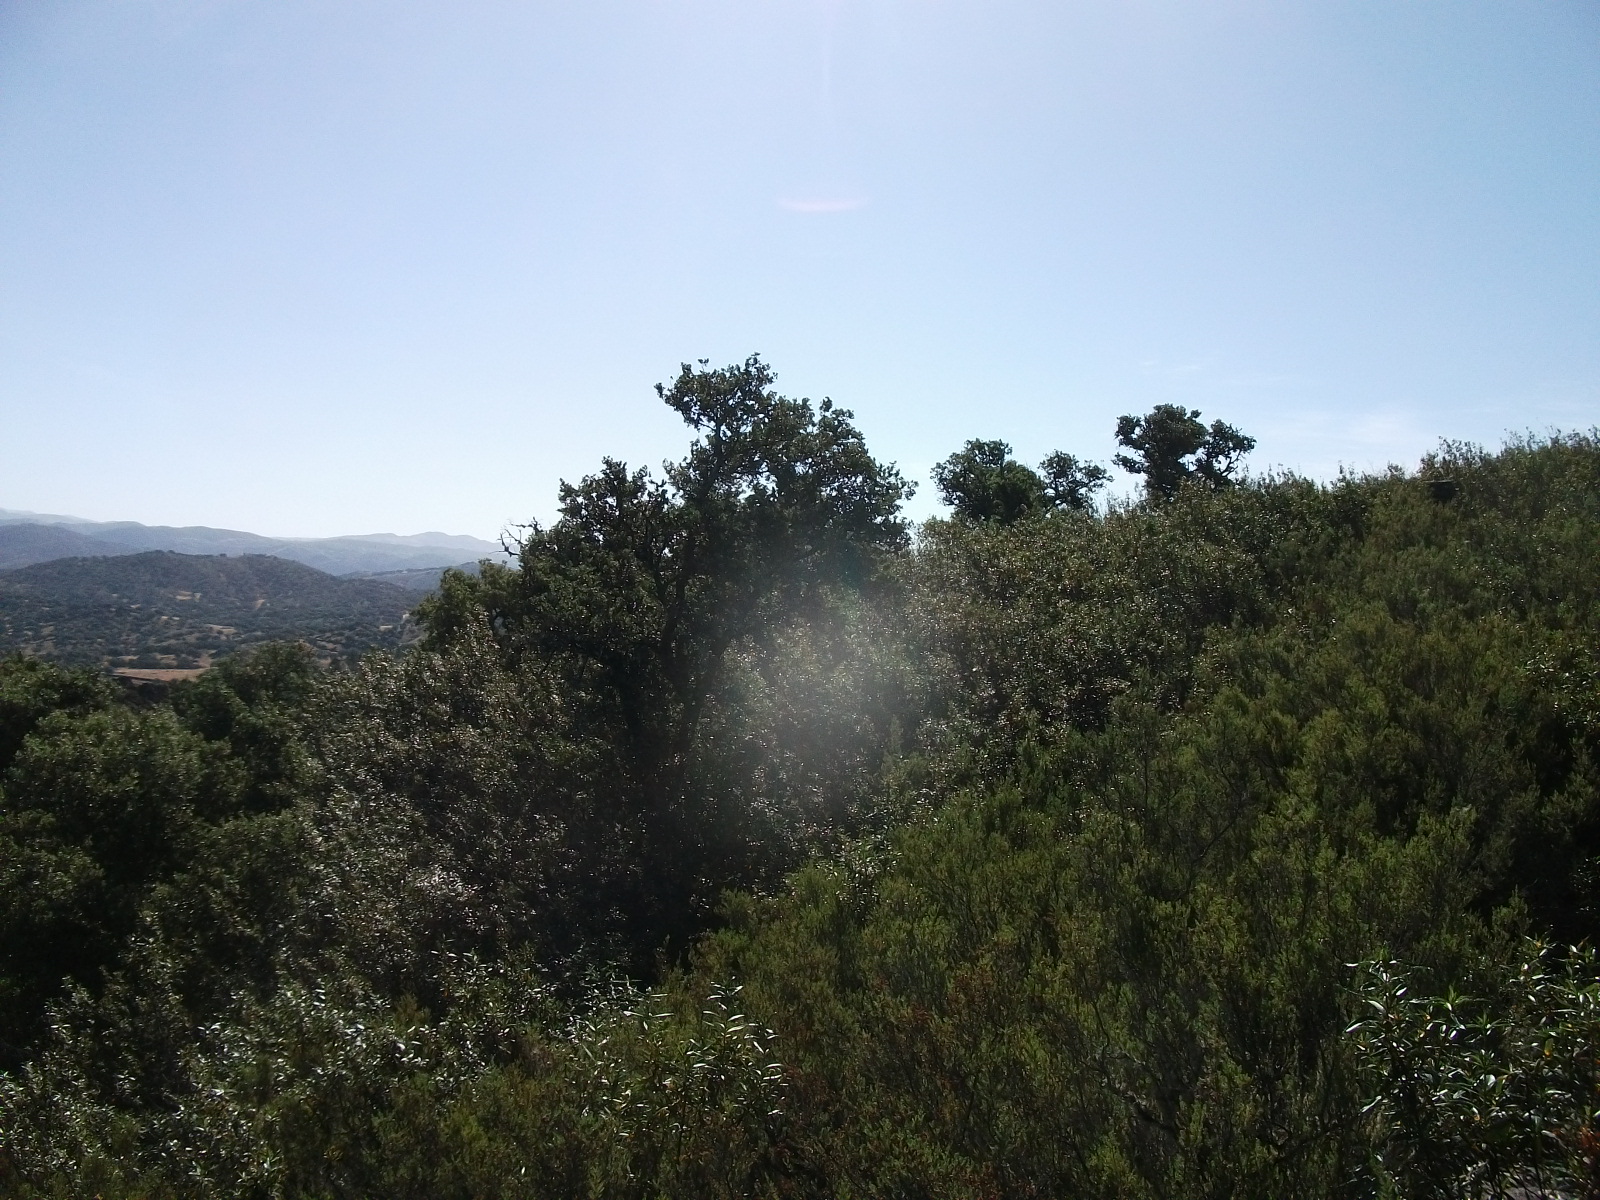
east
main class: Shrubland
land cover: Shrubland without tree cover
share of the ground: > 75 %
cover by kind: shrubs 100 %
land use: Agriculture (excluding fallow land and kitchen gardens)
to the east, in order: Shrubland without tree cover; Dry stone walls; Broadleaved woodland; Tracks; Broadleaved woodland
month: May
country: ES
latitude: 37.9424
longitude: -6.5783
